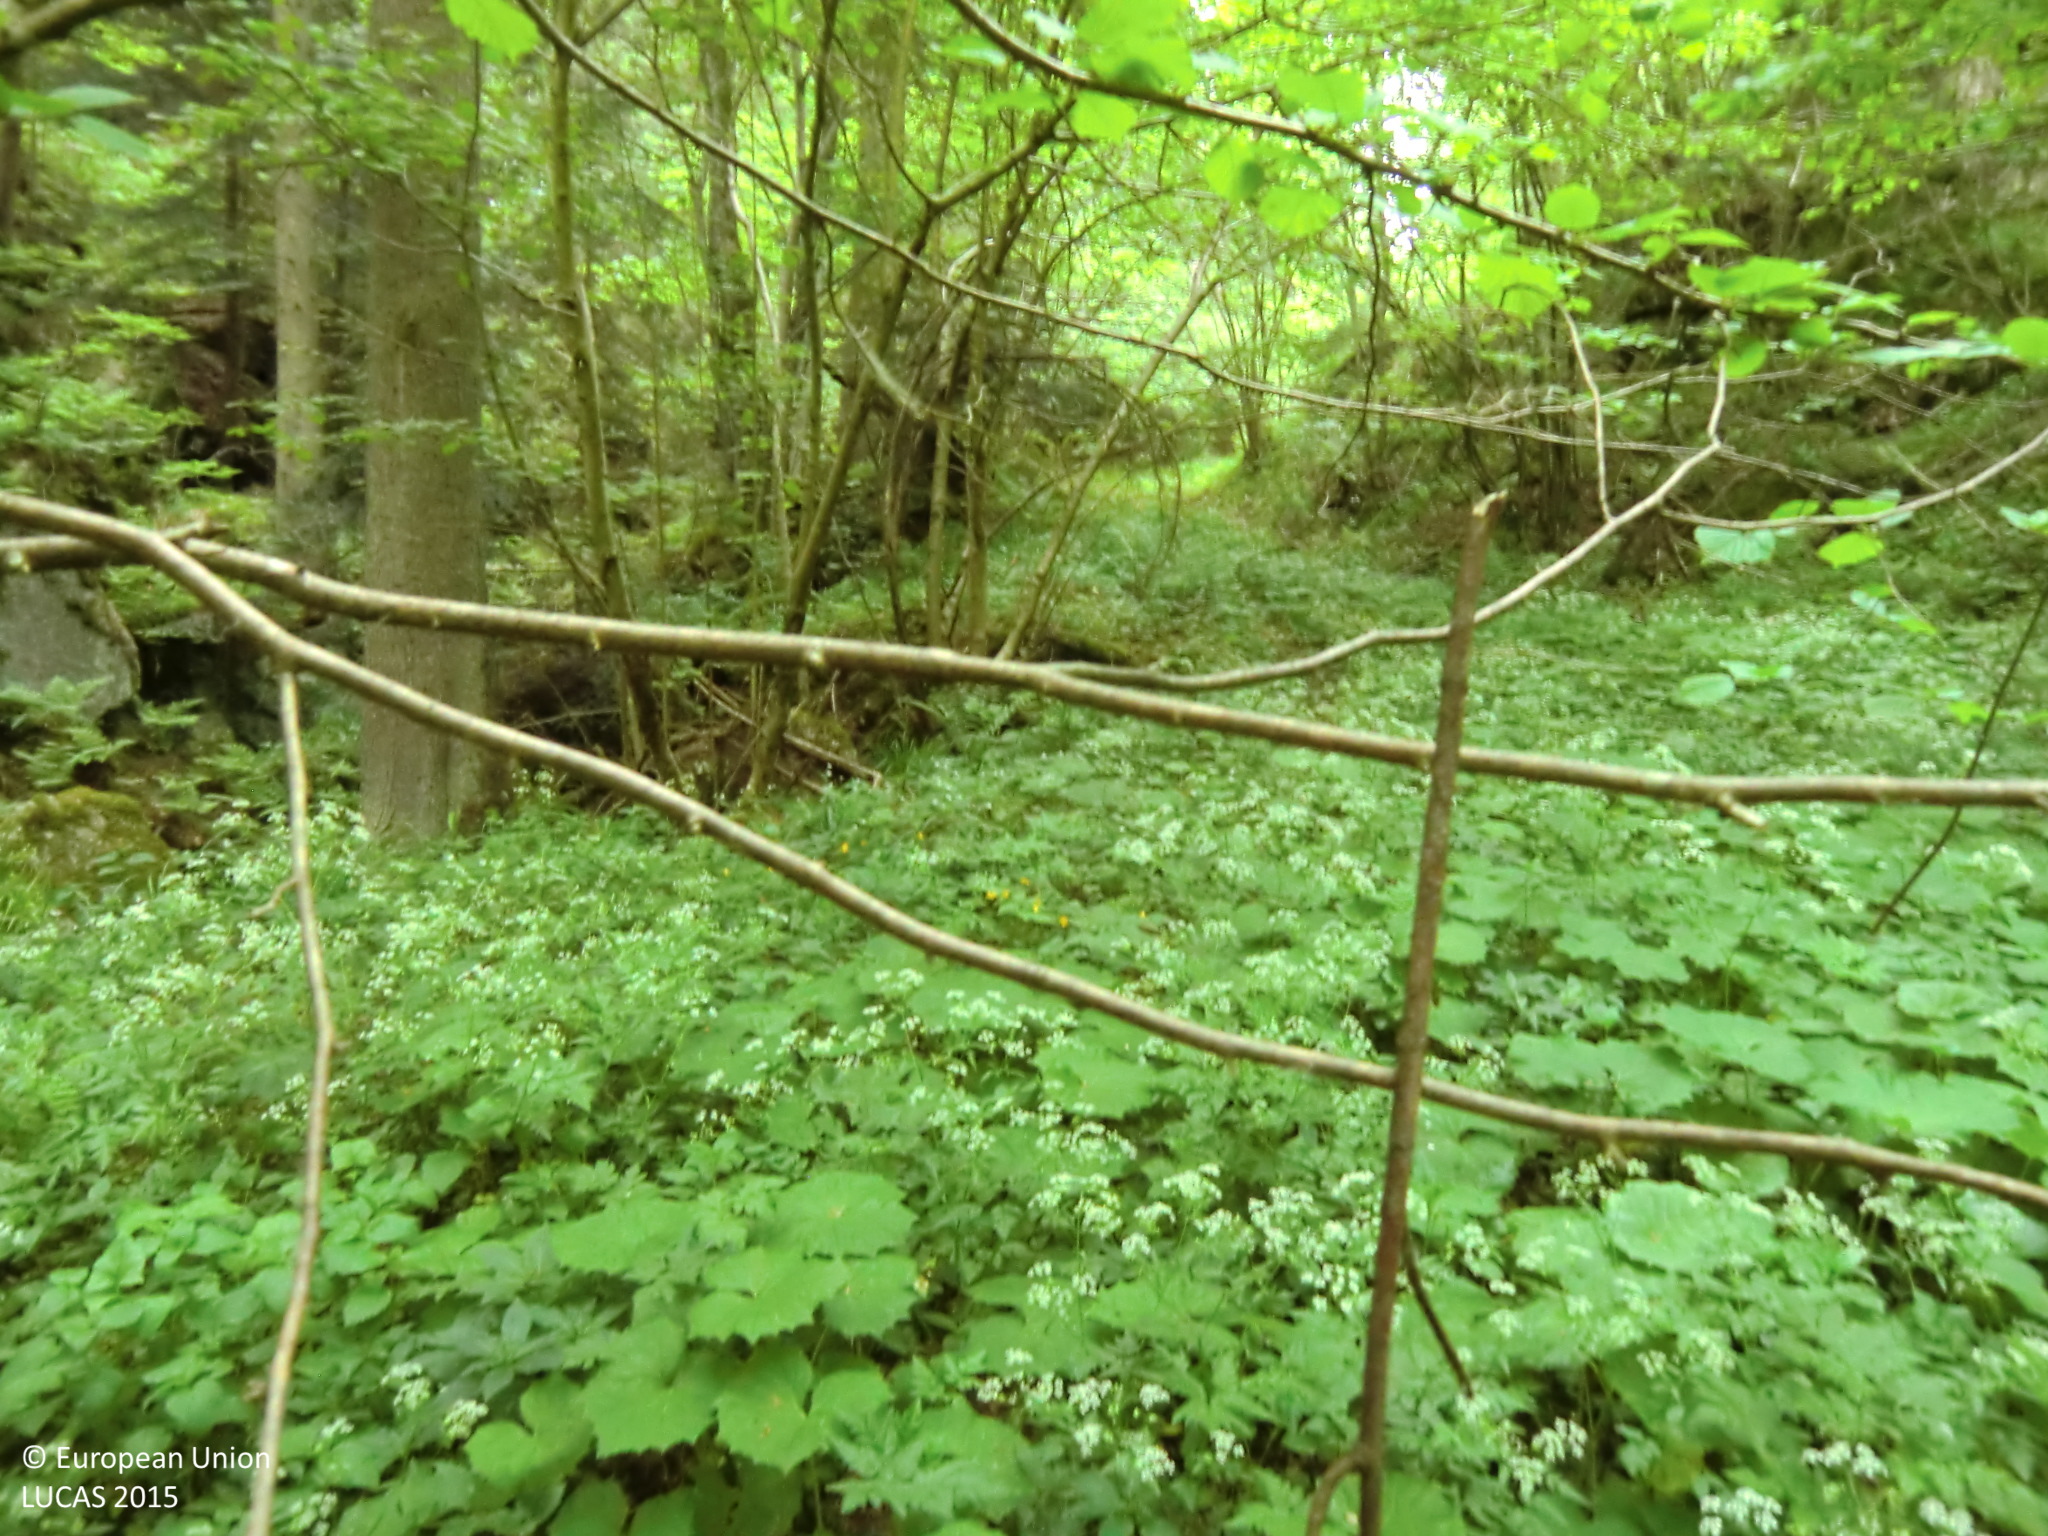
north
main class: Woodland
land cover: Spruce dominated mixed woodland
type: hemiboreal forest and nemoral coniferous forest and mixed broadleaved-coniferous forest
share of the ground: > 75 %
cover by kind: coniferous forest trees 40 %, broadleaved forest trees 40 %, shrubs 10 %, herbaceous plants 10 %
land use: Forestry
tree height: > 5 m
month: May
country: AT
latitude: 48.3646
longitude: 14.9550
